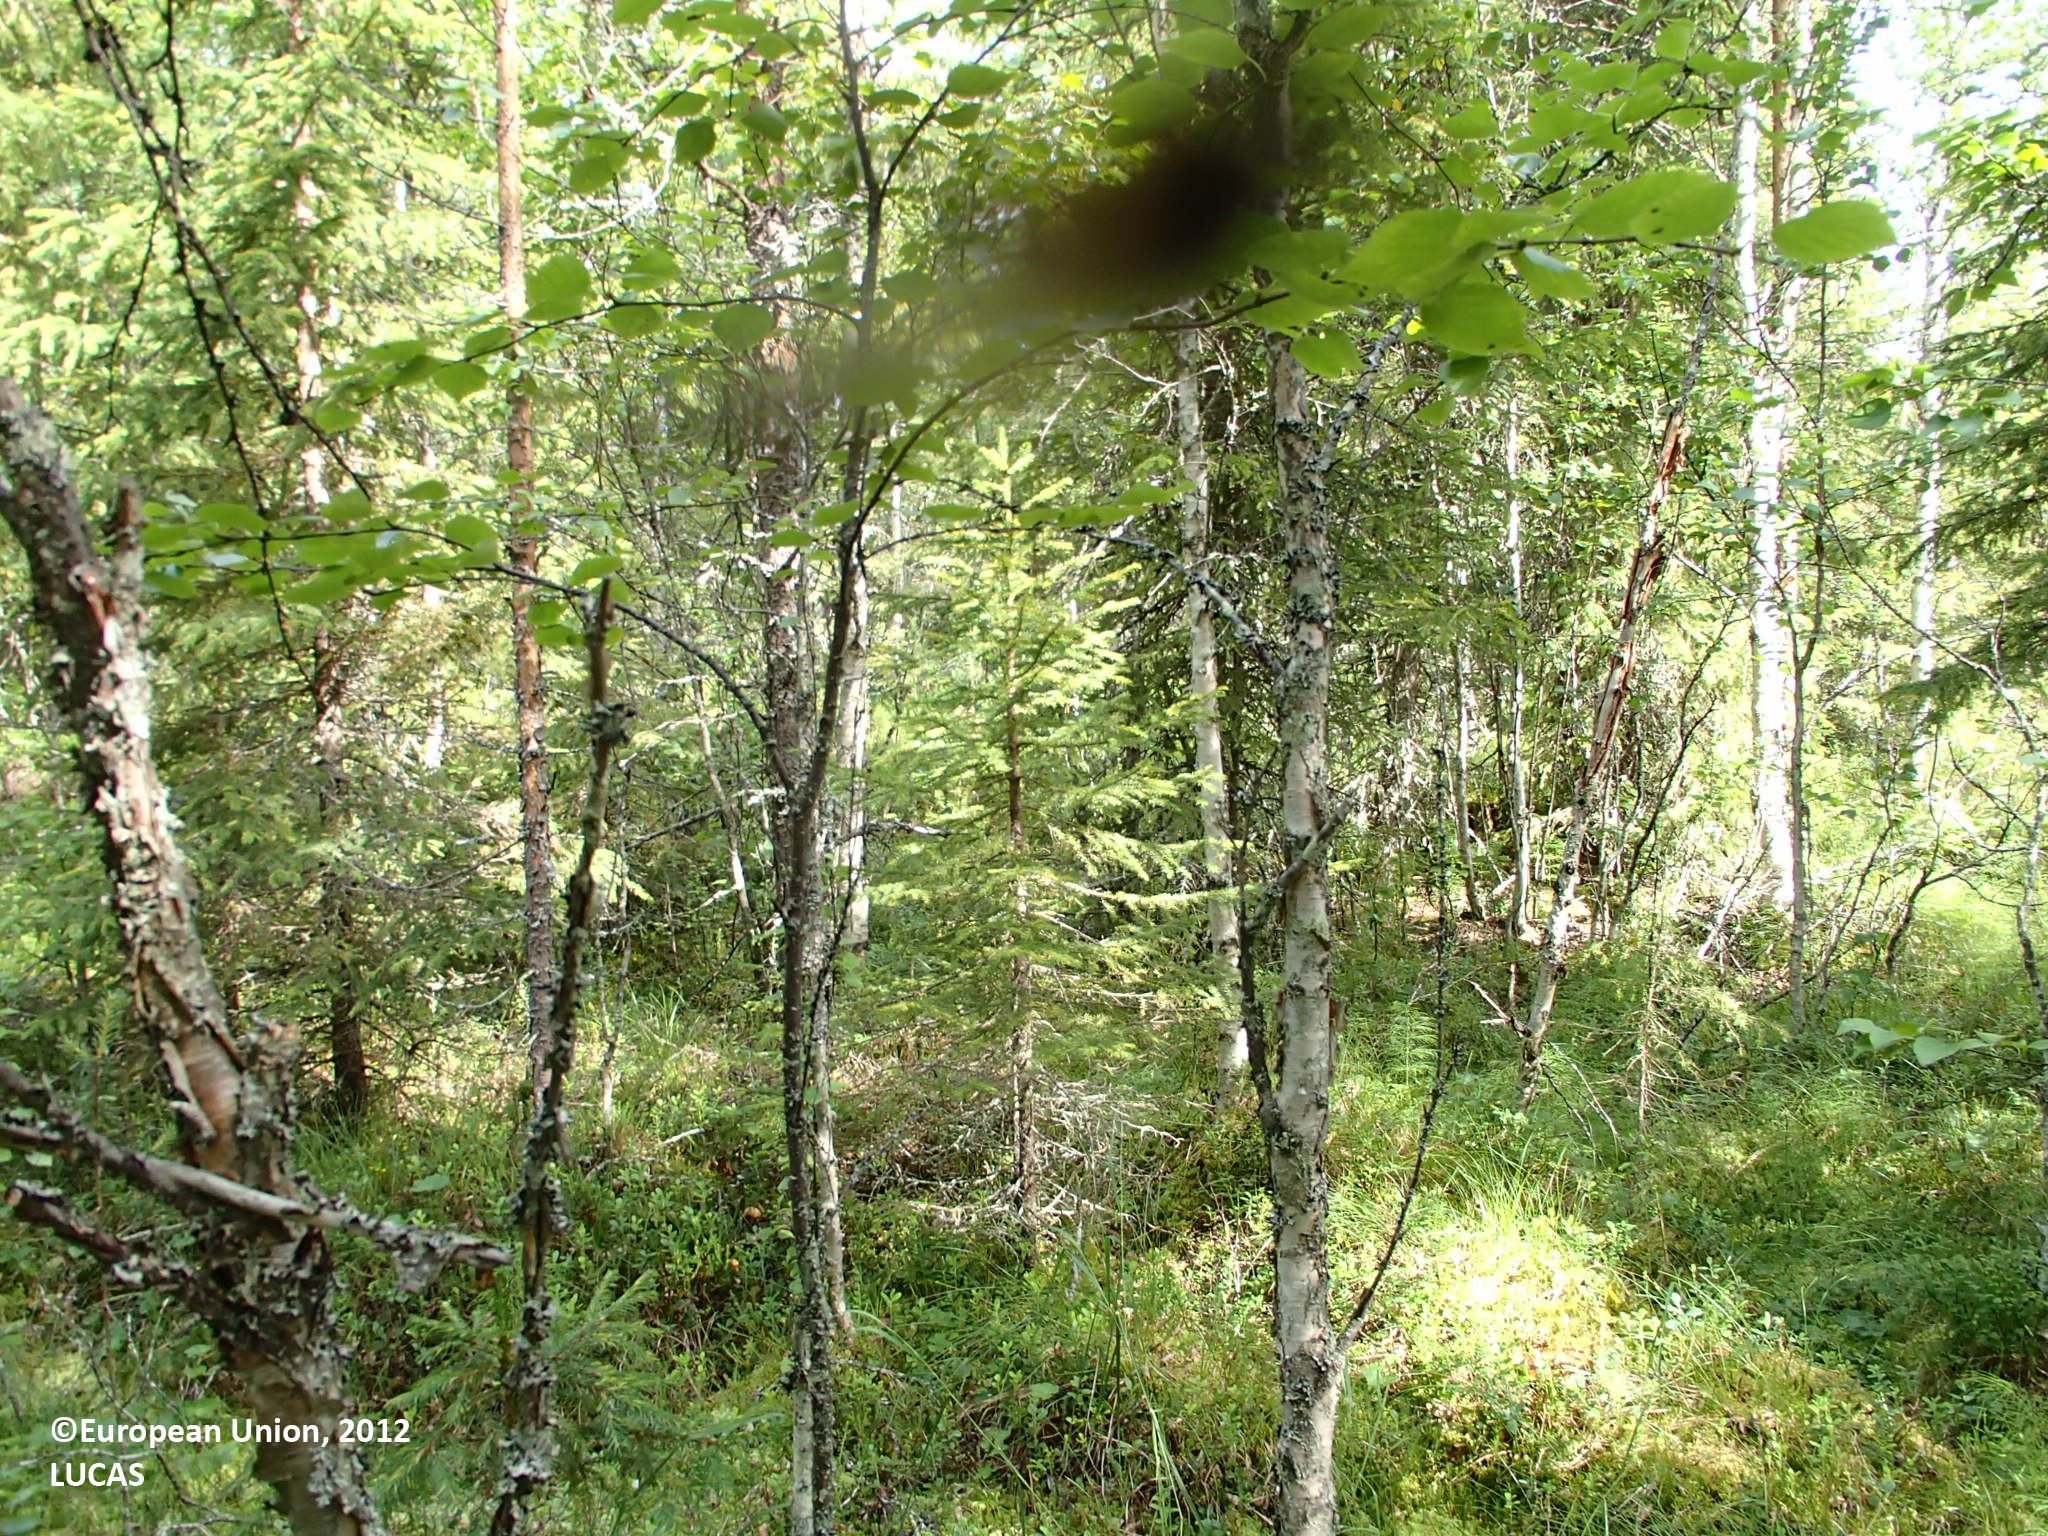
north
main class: Woodland
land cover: Other mixed woodland
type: boreal forest
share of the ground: > 75 %
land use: Forestry
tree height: > 5 m
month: July
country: FI
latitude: 66.3545
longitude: 25.4599
